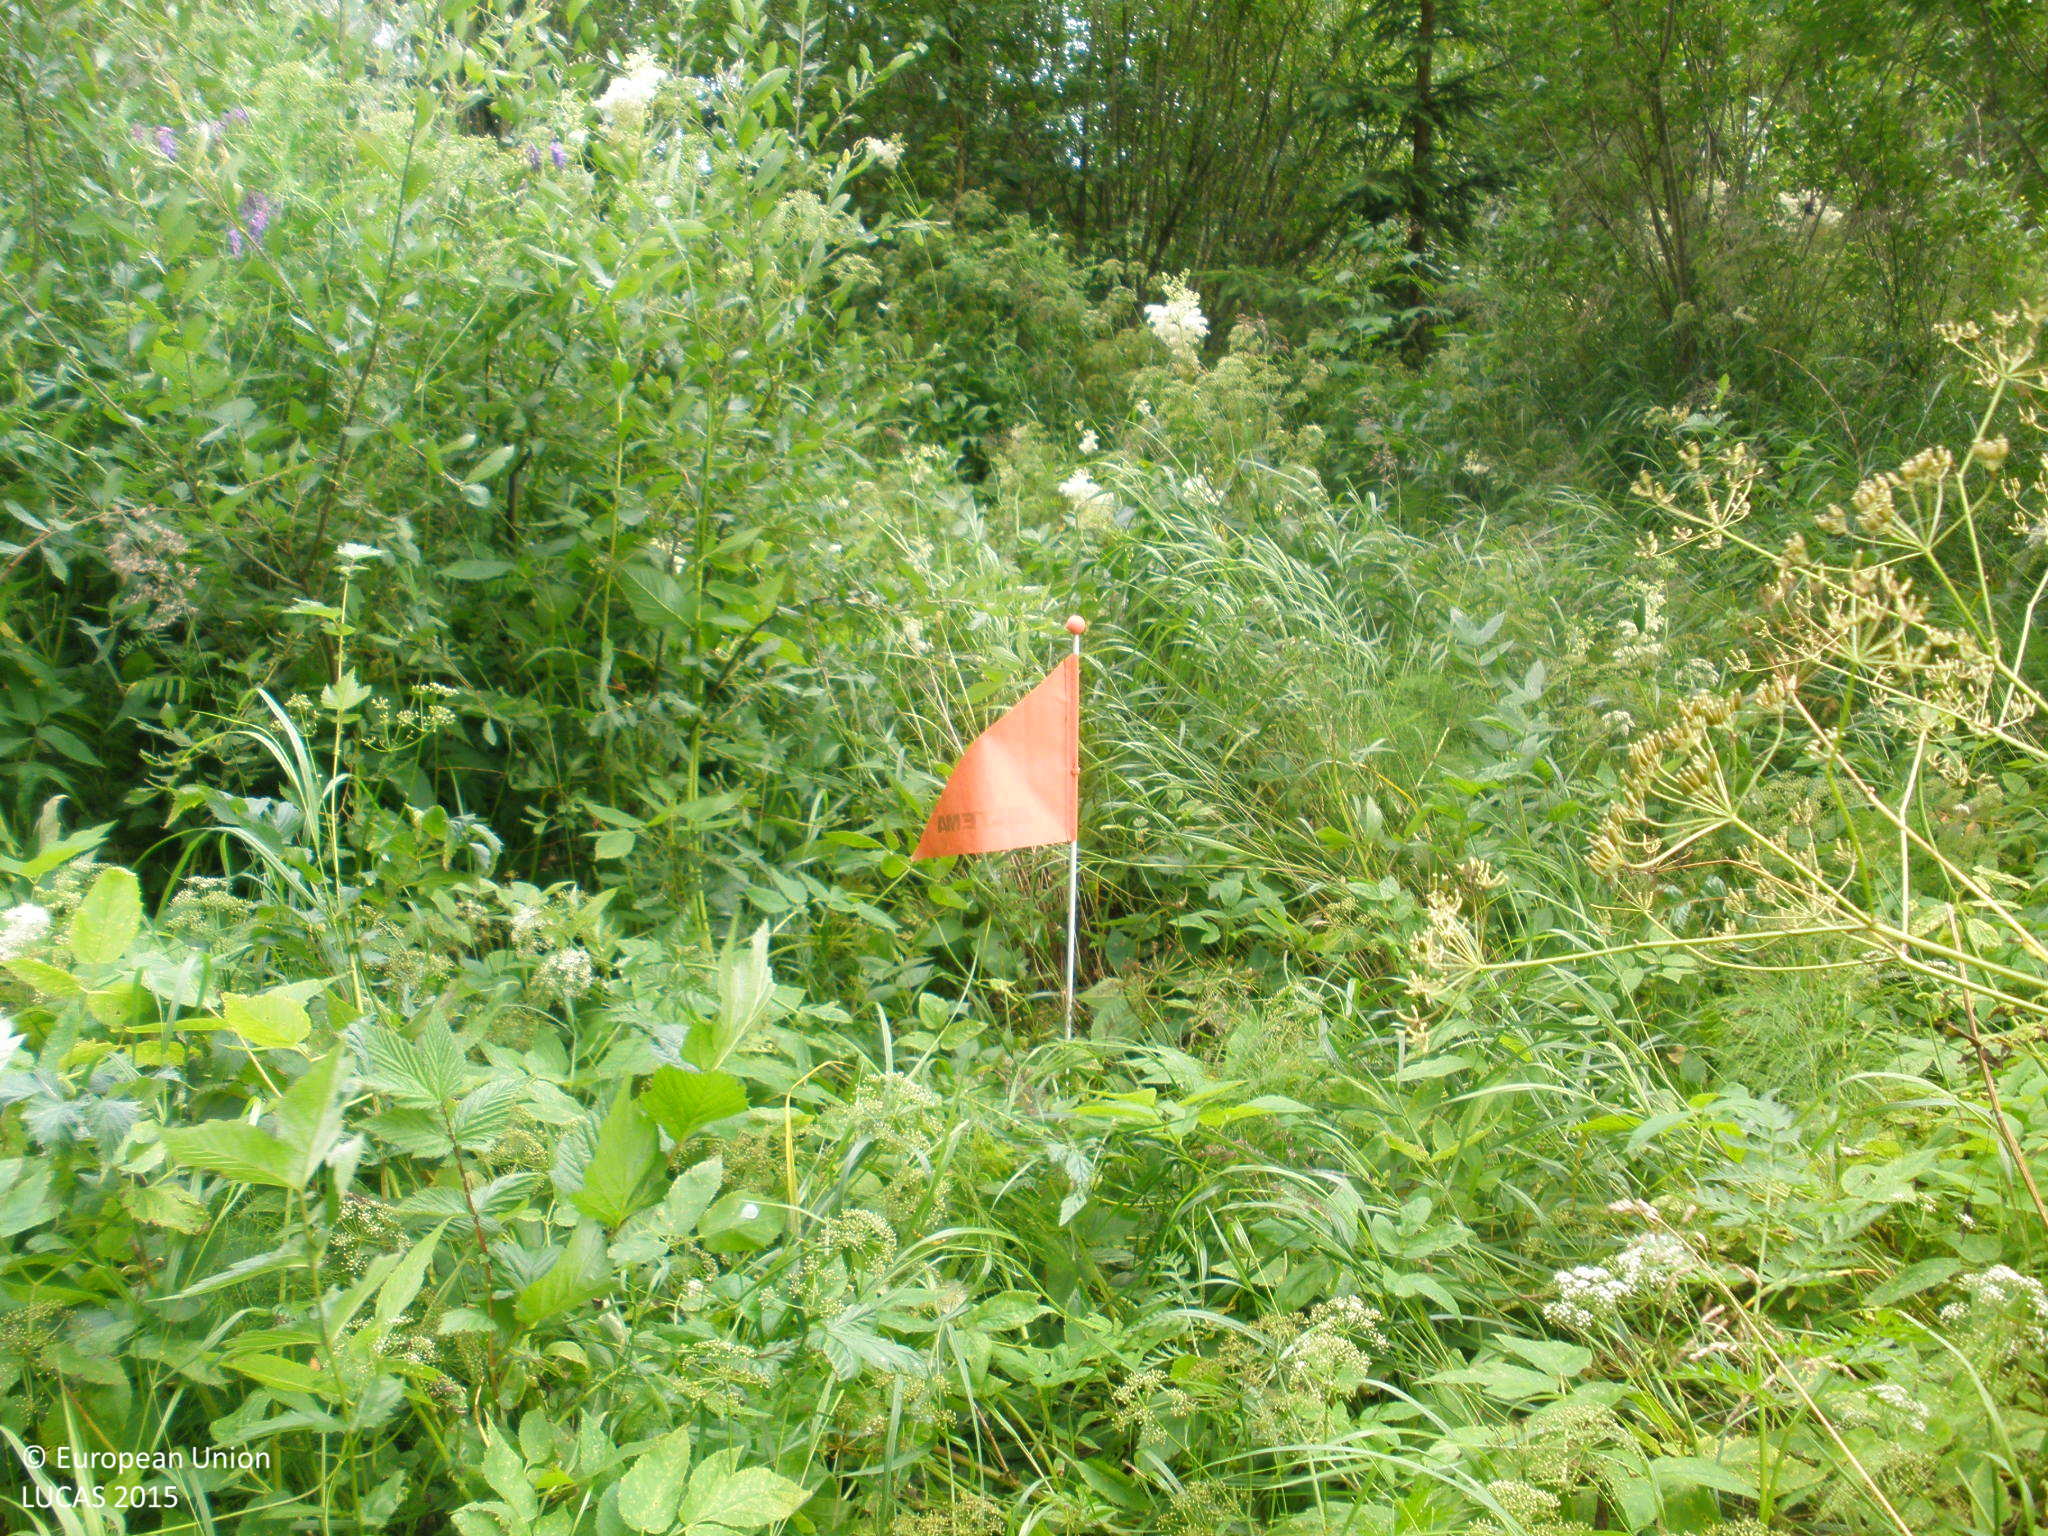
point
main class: Shrubland
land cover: Shrubland with sparse tree cover
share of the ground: 50 - 75 %
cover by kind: shrubs 50 %, herbaceous plants 45 %, broadleaved forest trees 5 %
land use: Semi-natural and natural areas not in use
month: July
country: FI
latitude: 60.6840
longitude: 23.4690
